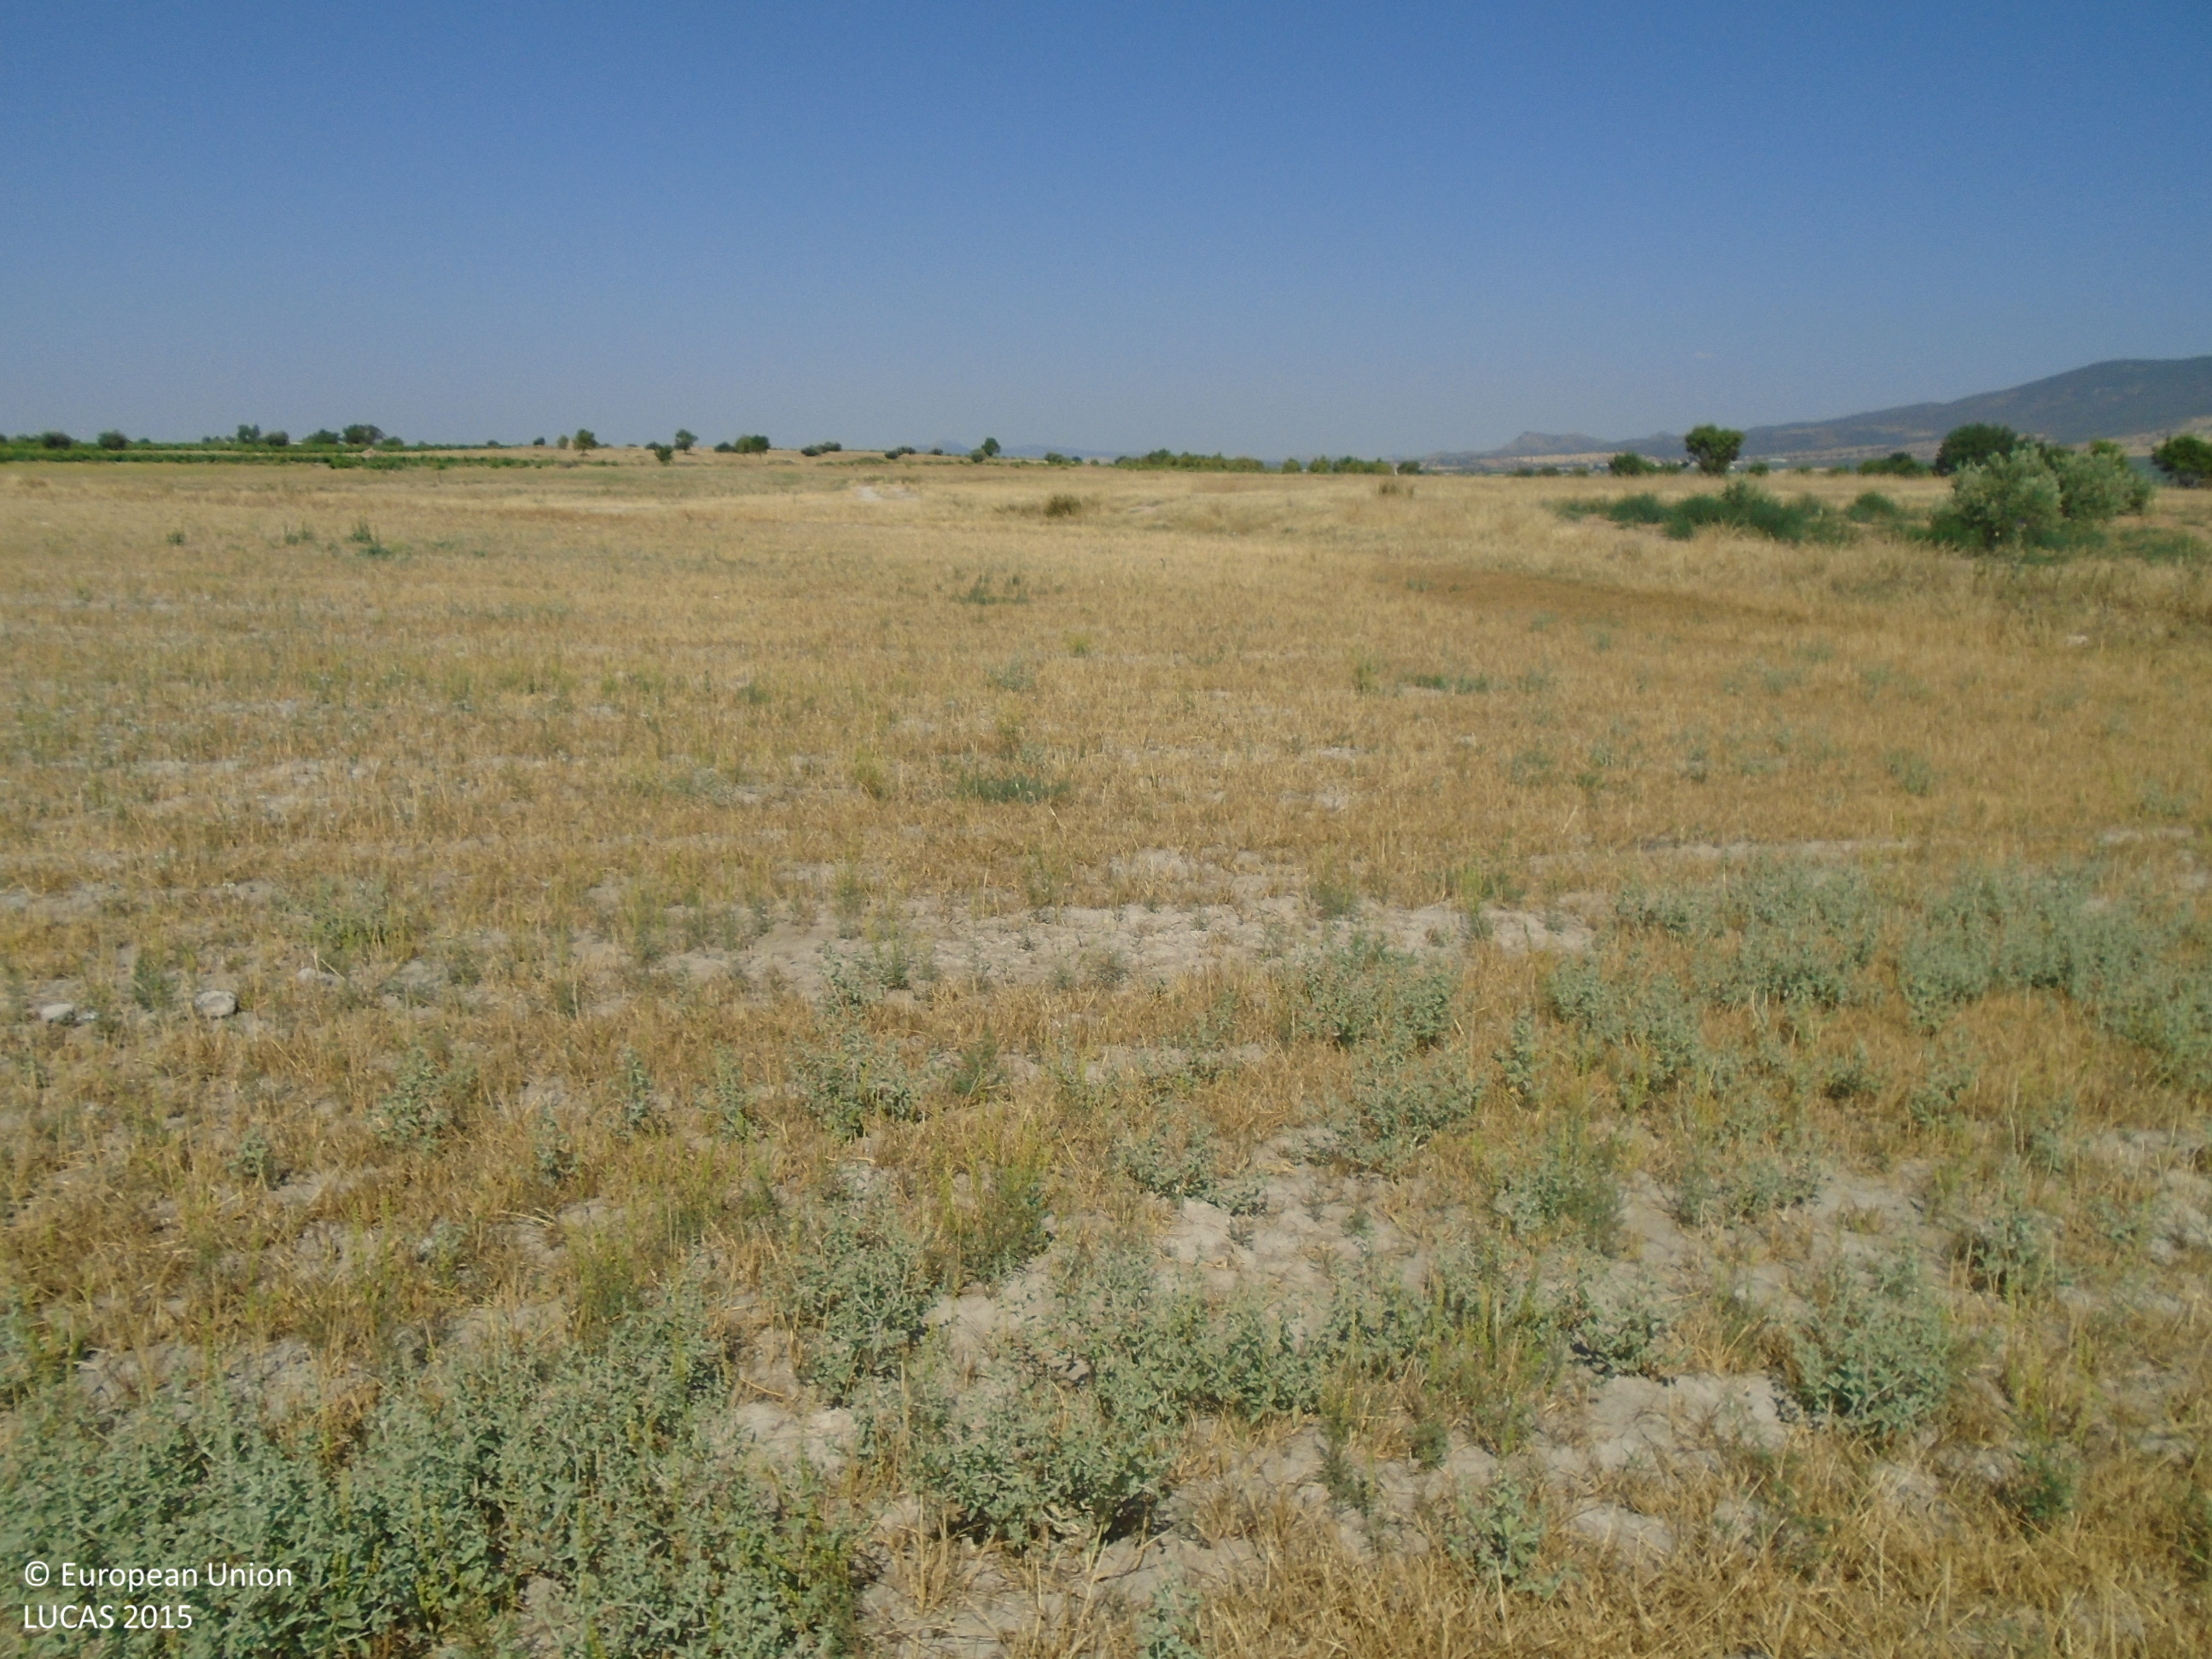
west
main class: Cropland
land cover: Barley
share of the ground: > 75 %
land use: Agriculture (excluding fallow land and kitchen gardens)
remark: Harvested field
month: June
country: ES
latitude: 39.1840
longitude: -3.6223
